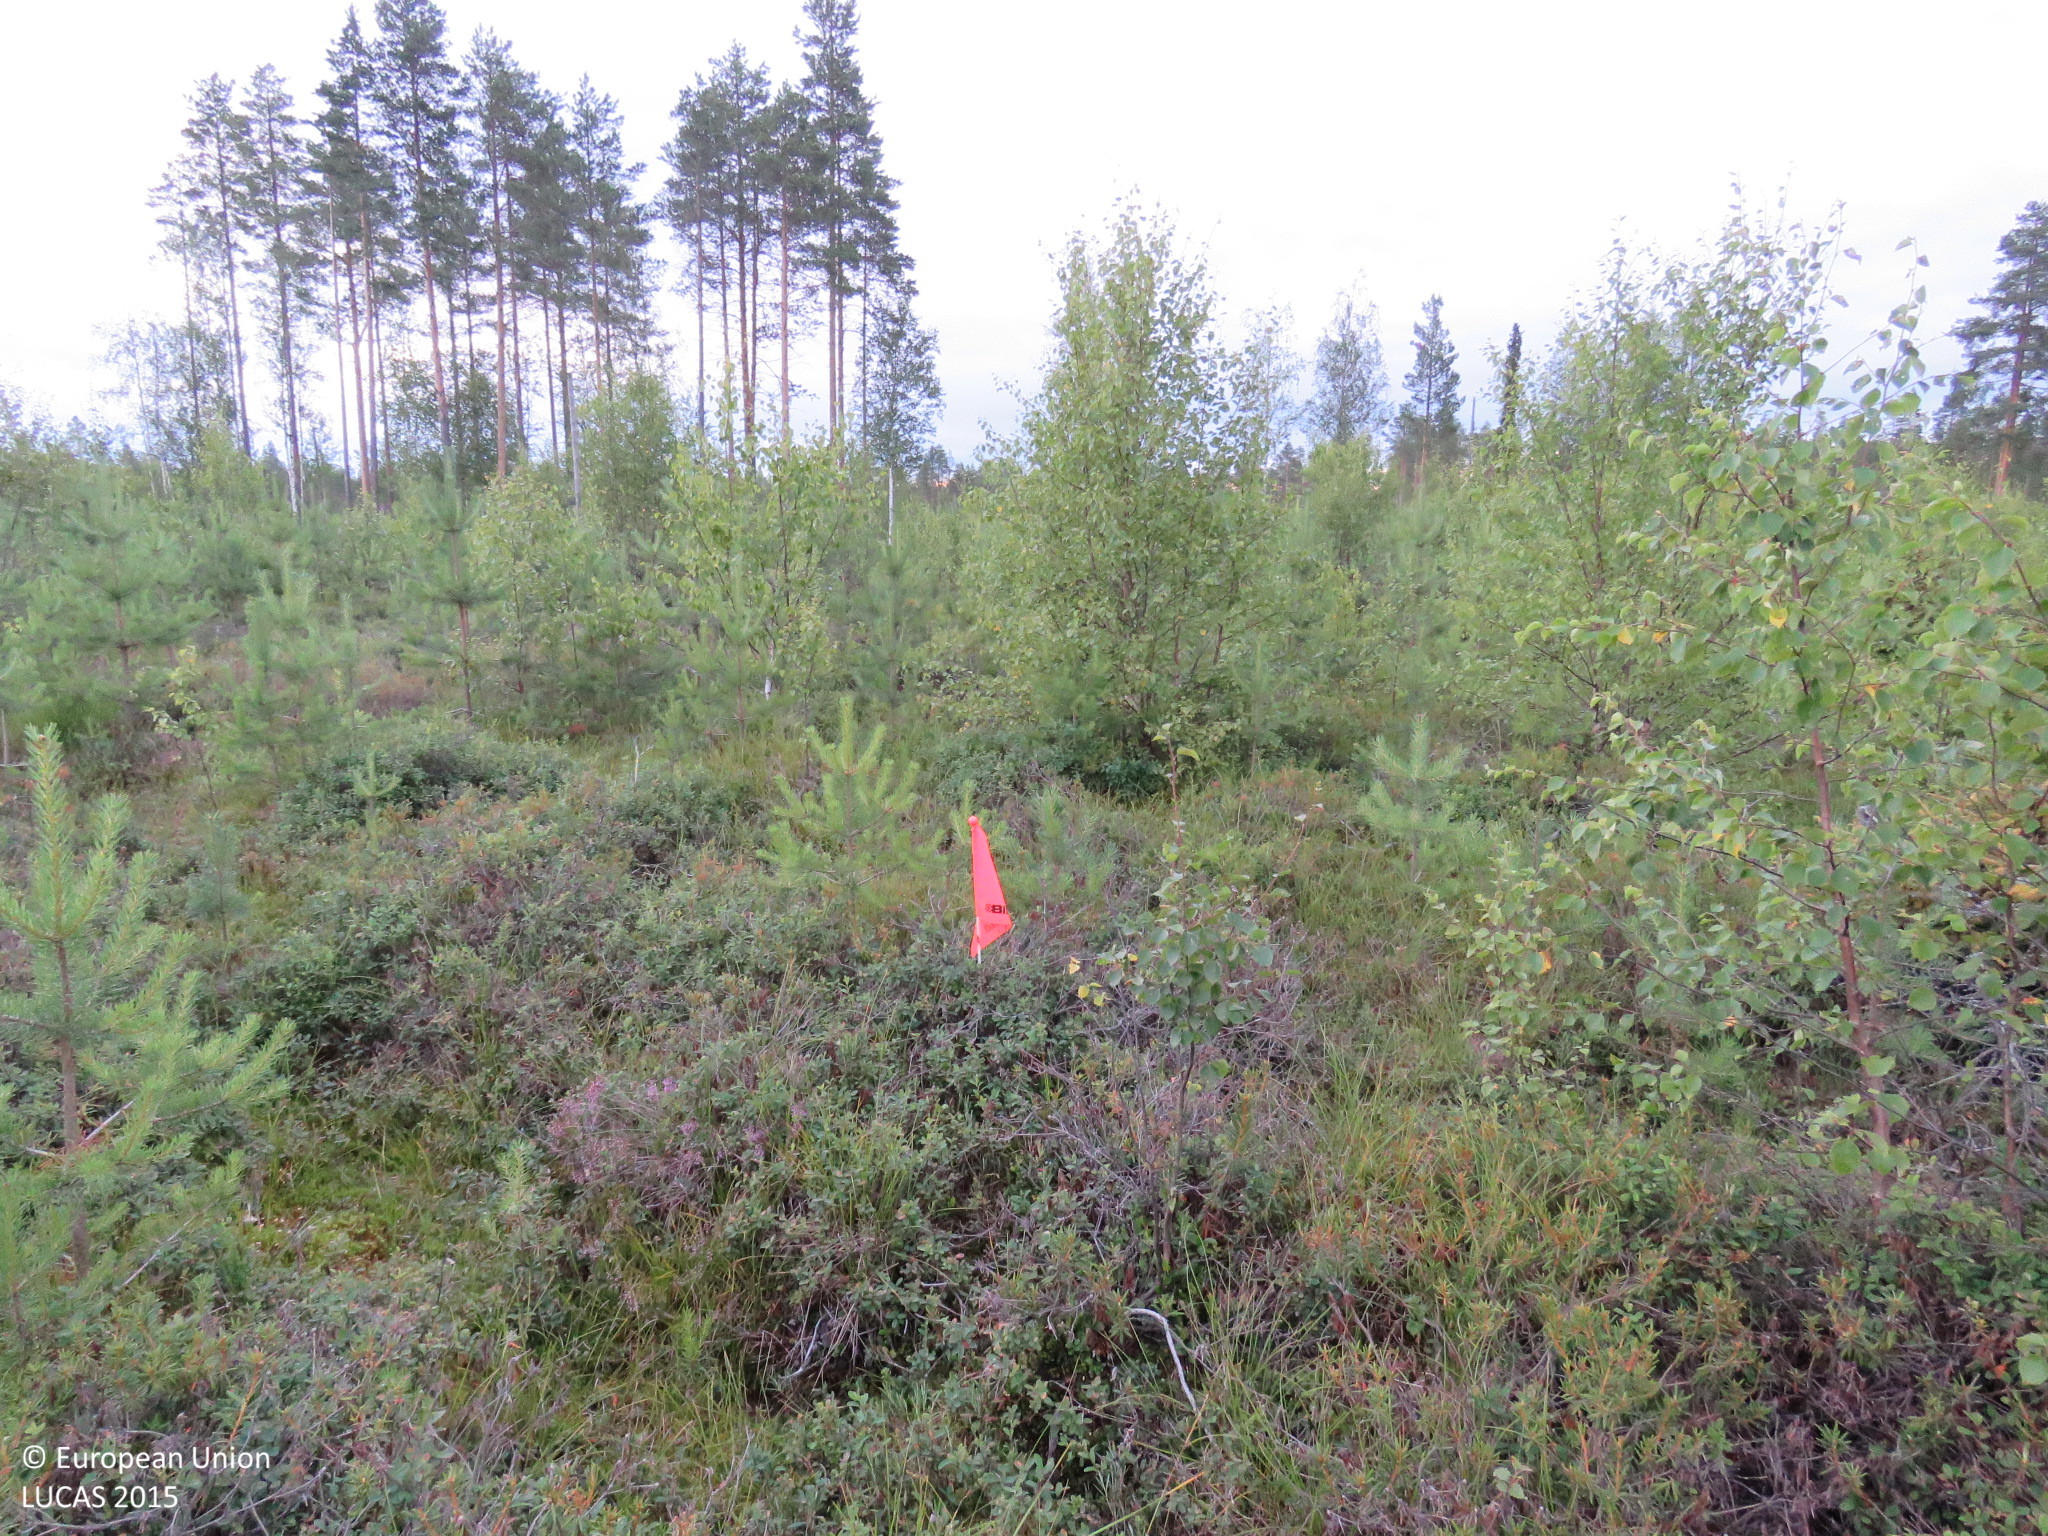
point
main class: Woodland
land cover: Pine dominated mixed woodland
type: boreal forest
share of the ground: 50 - 75 %
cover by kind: coniferous forest trees 30 %, broadleaved forest trees 30 %, shrubs 20 %, lichens and mosses 15 %, herbaceous plants 5 %
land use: Forestry
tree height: < 5 m
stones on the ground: < 10 %
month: July
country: FI
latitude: 64.6865
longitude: 26.5687
